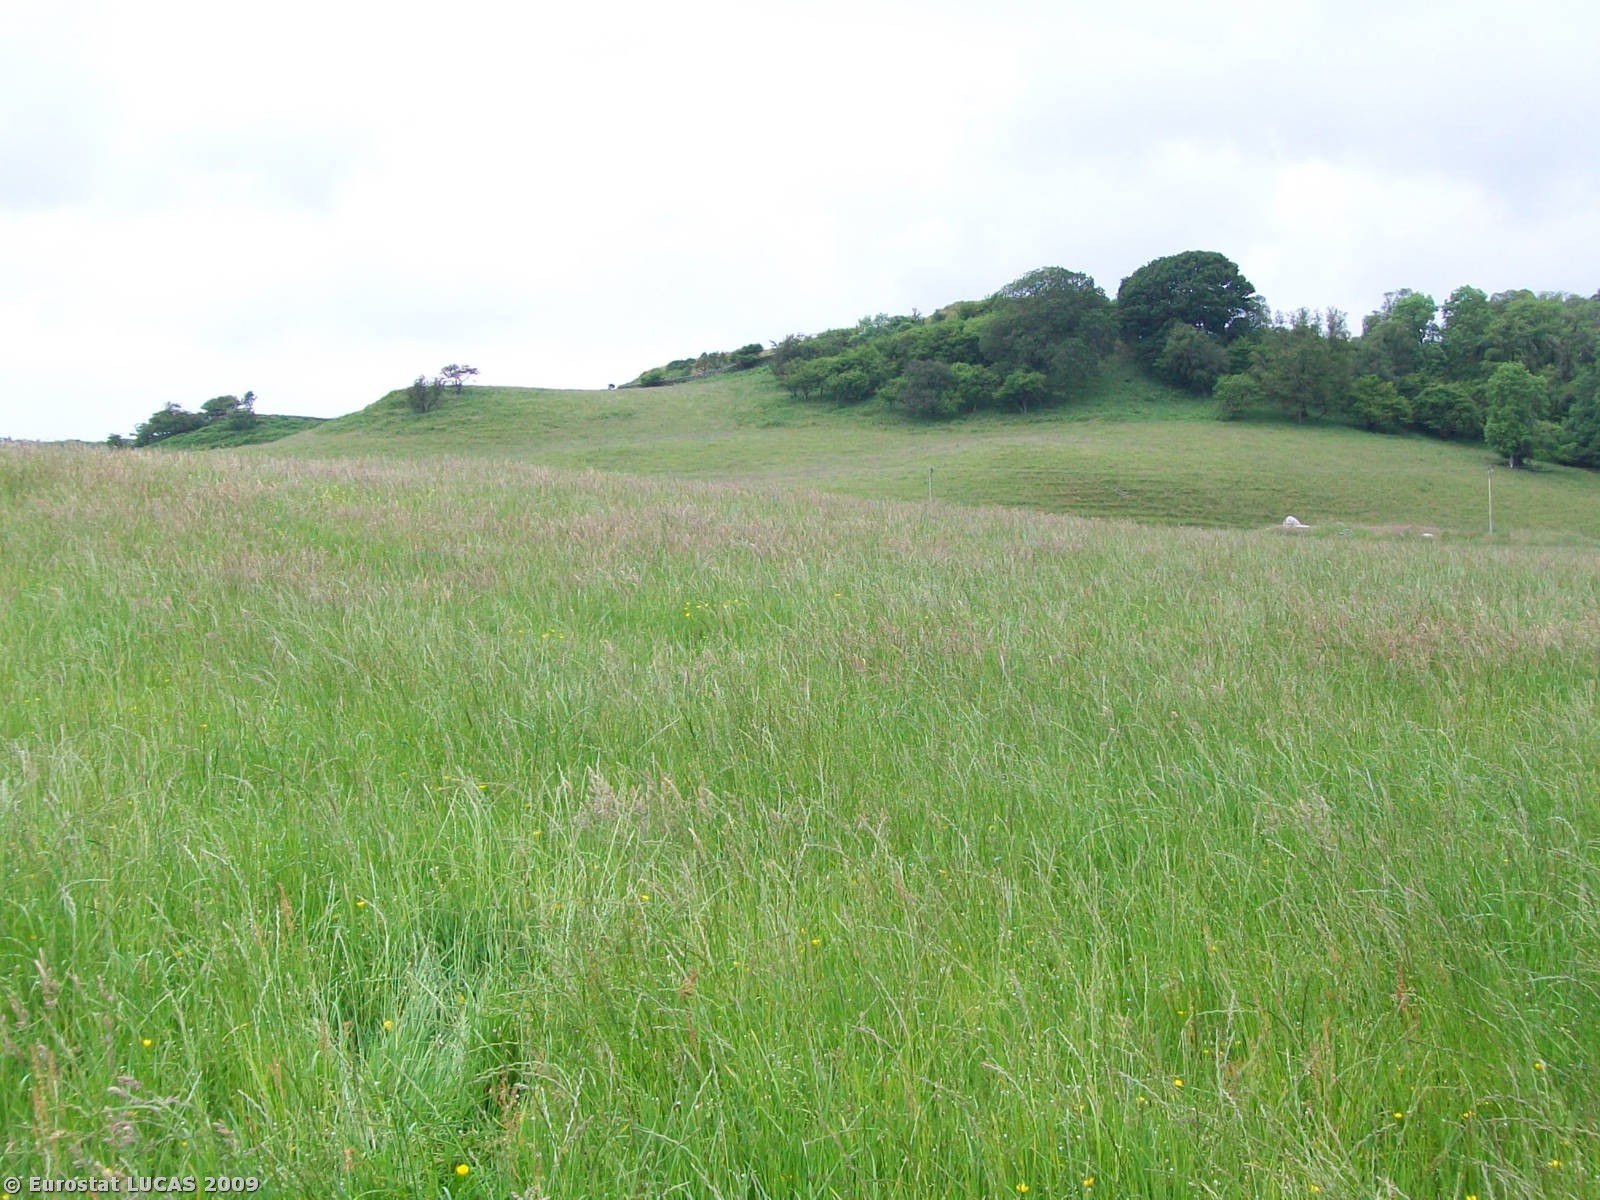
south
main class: Grassland
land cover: Grassland without tree/shrub cover
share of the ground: > 75 %
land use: Agriculture (excluding fallow land and kitchen gardens)
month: June
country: GB
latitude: 54.9505
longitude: -4.0666
